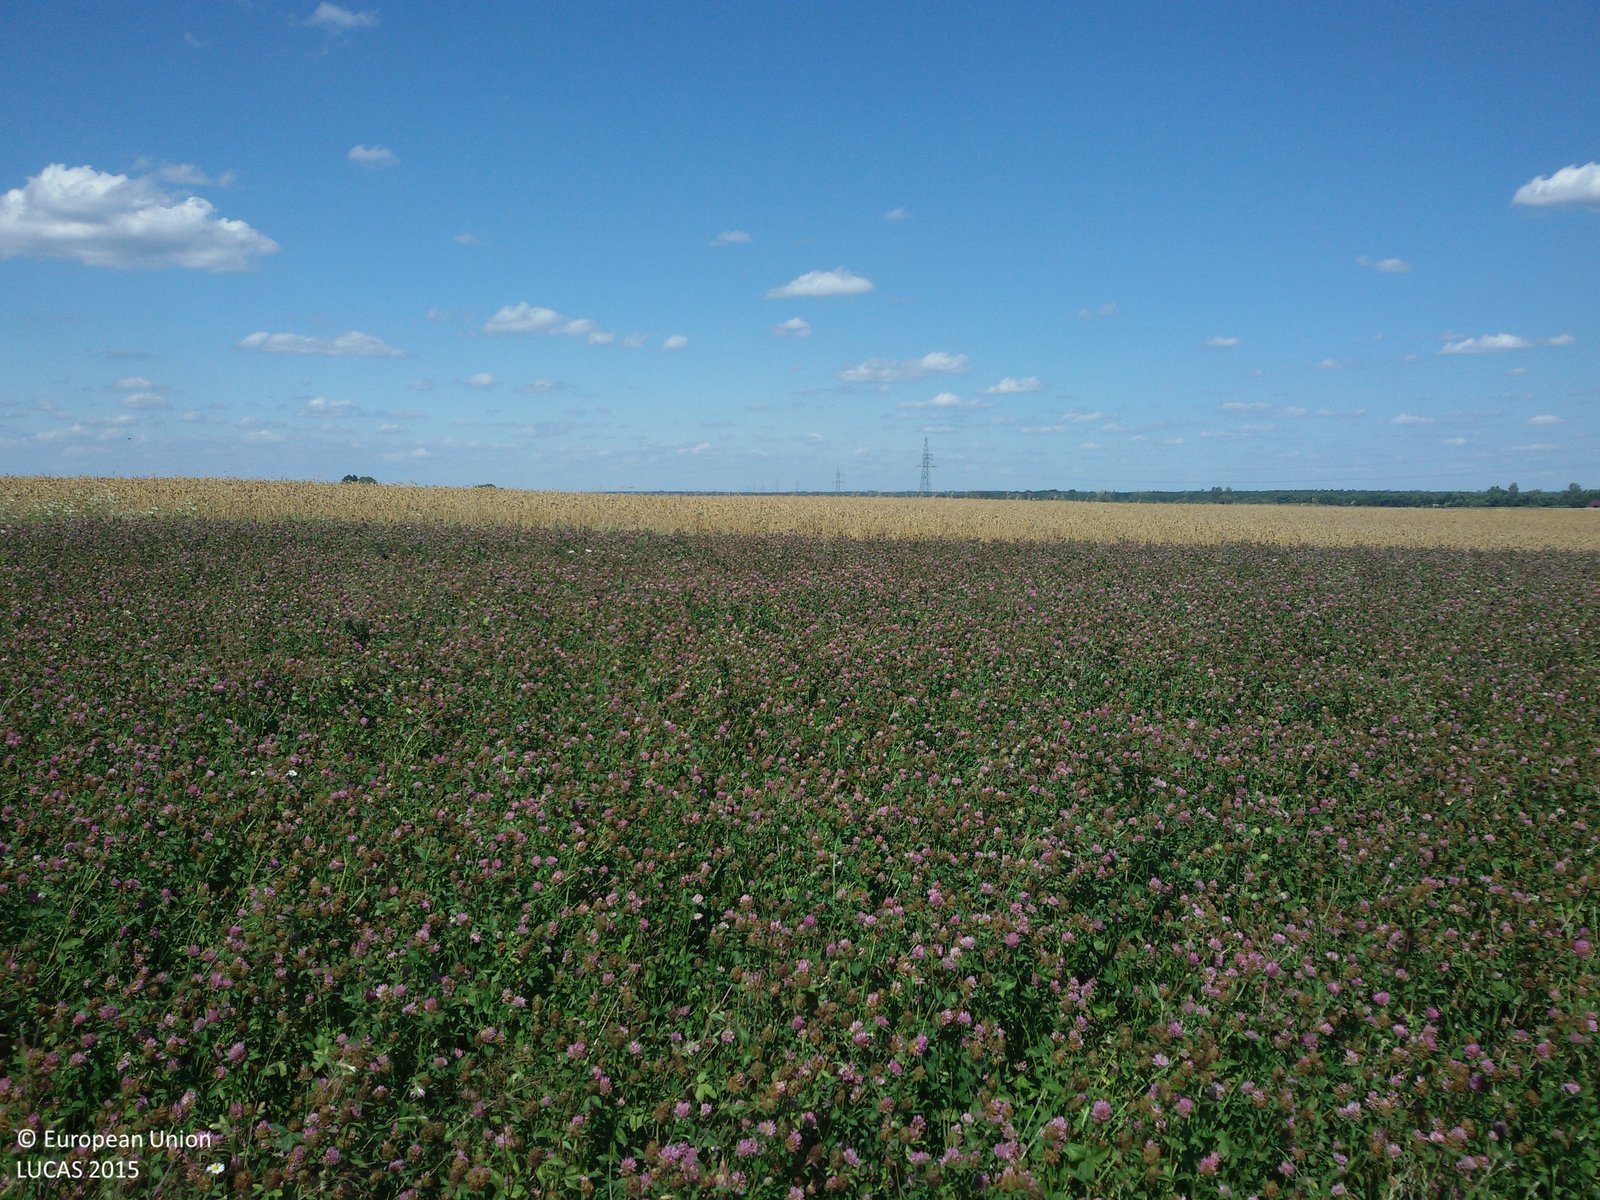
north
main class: Cropland
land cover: Clovers
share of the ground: > 75 %
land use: Agriculture (excluding fallow land and kitchen gardens)
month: July
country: PL
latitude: 51.2285
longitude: 23.4150
